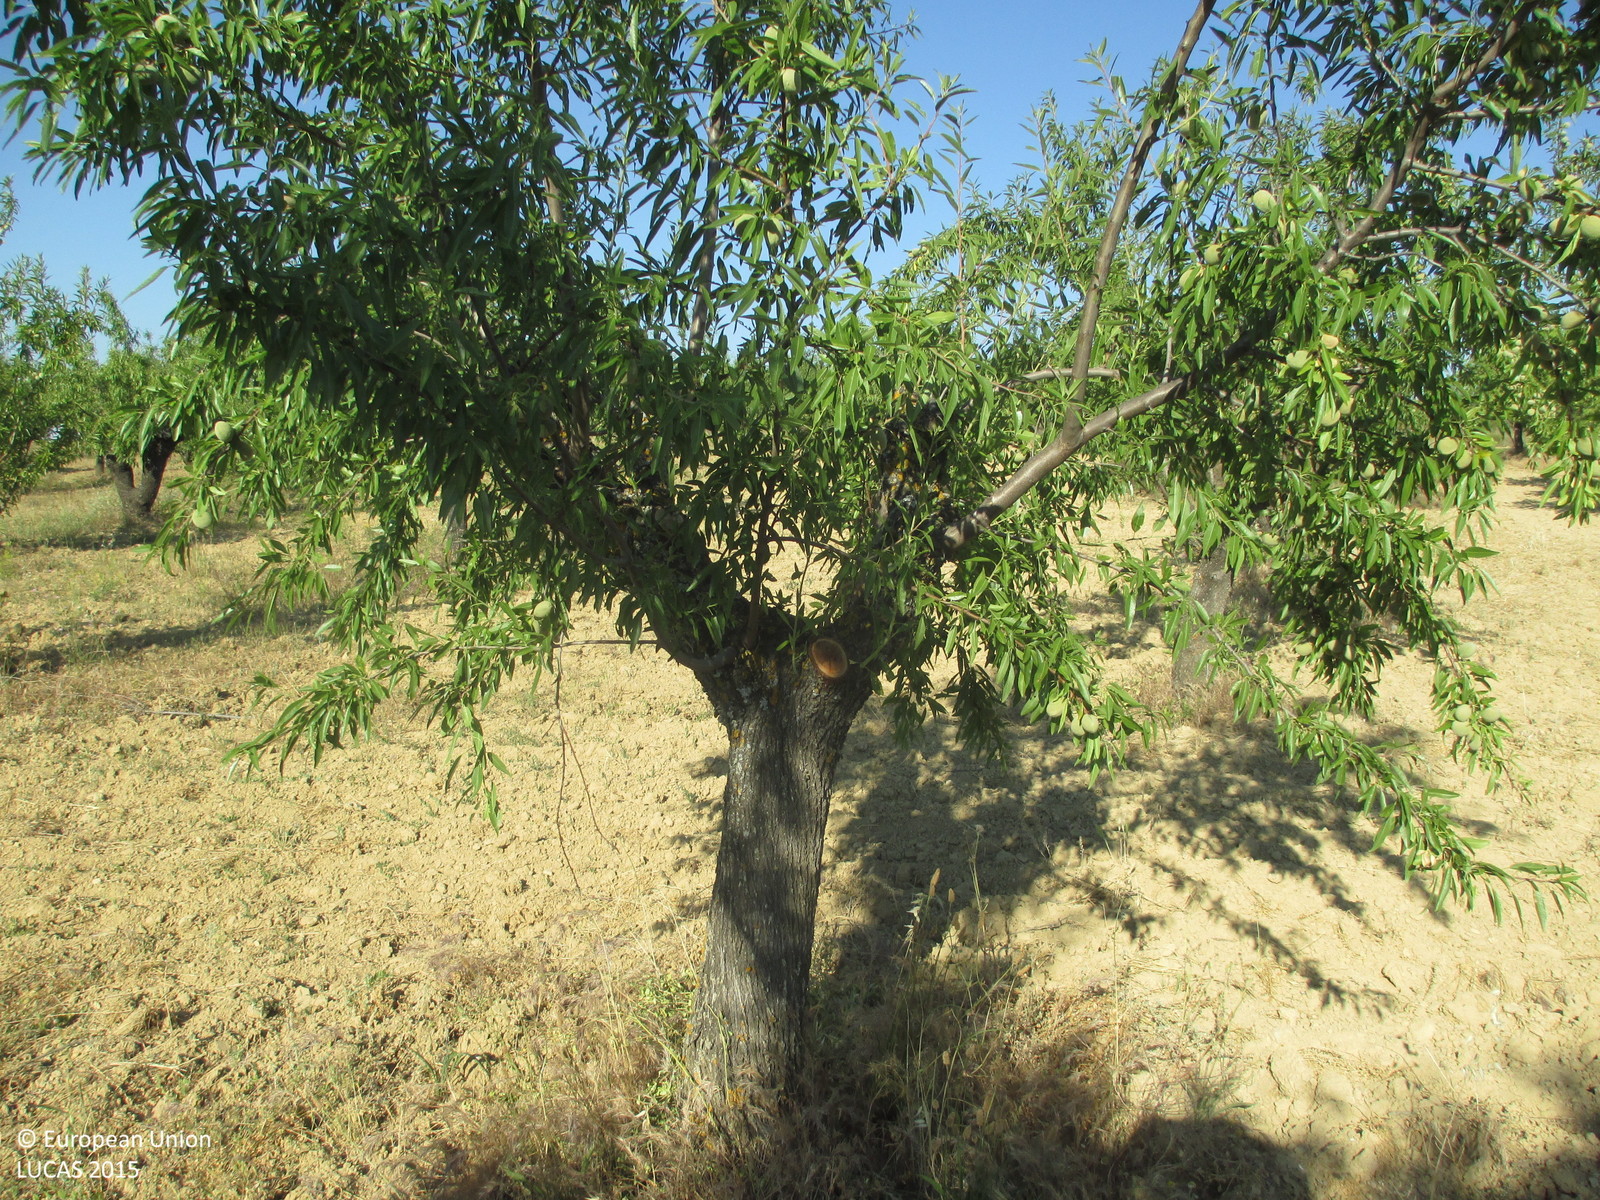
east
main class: Cropland
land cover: Nuts trees
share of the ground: 50 - 75 %
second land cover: Other bare soil
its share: > 75 %
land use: Agriculture (excluding fallow land and kitchen gardens)
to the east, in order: Nuts trees; Other bare soil; Grassland with sparse tree/shrub cover; Dry stone walls; Shrubland with sparse tree cover; Nuts trees; Dry stone walls; Tracks; Shruby margins; Shrubland with sparse tree cover
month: June
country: ES
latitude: 42.1217
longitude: 0.0012
